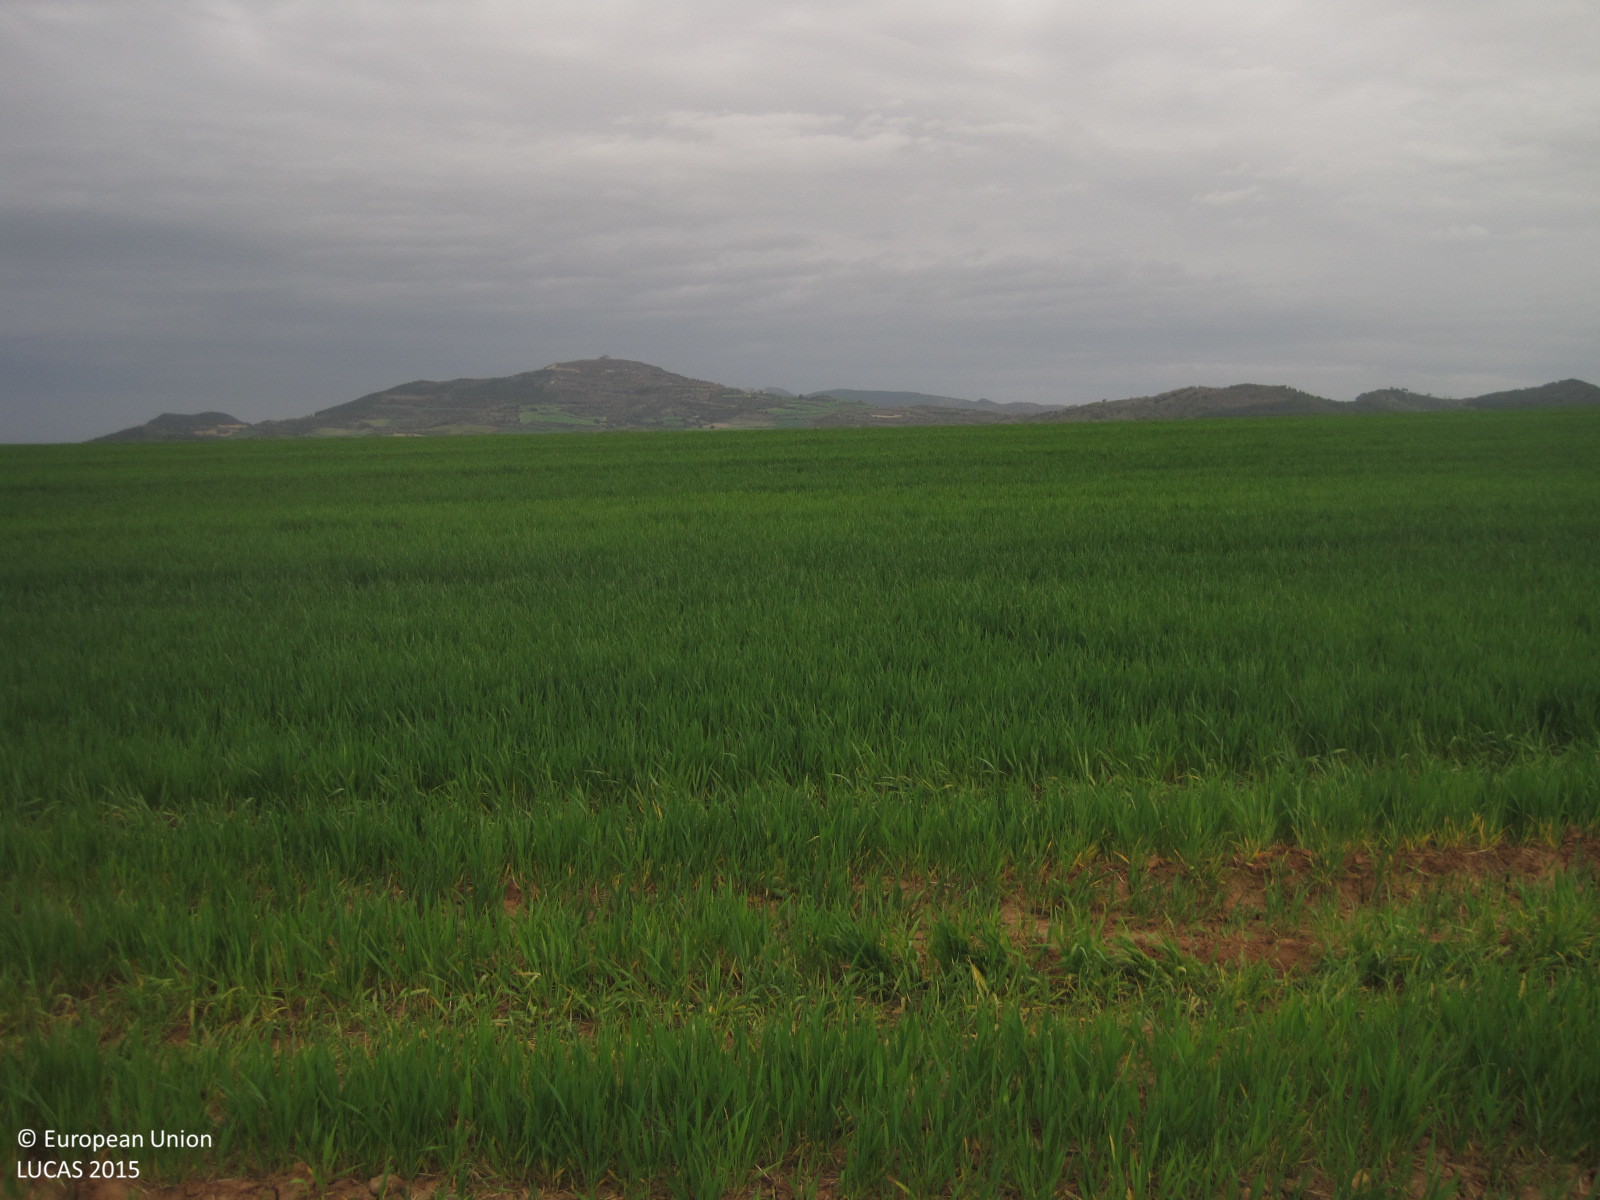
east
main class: Cropland
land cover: Barley
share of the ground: > 75 %
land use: Agriculture (excluding fallow land and kitchen gardens)
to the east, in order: Barley
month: April
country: ES
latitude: 42.6279
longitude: -2.1756
